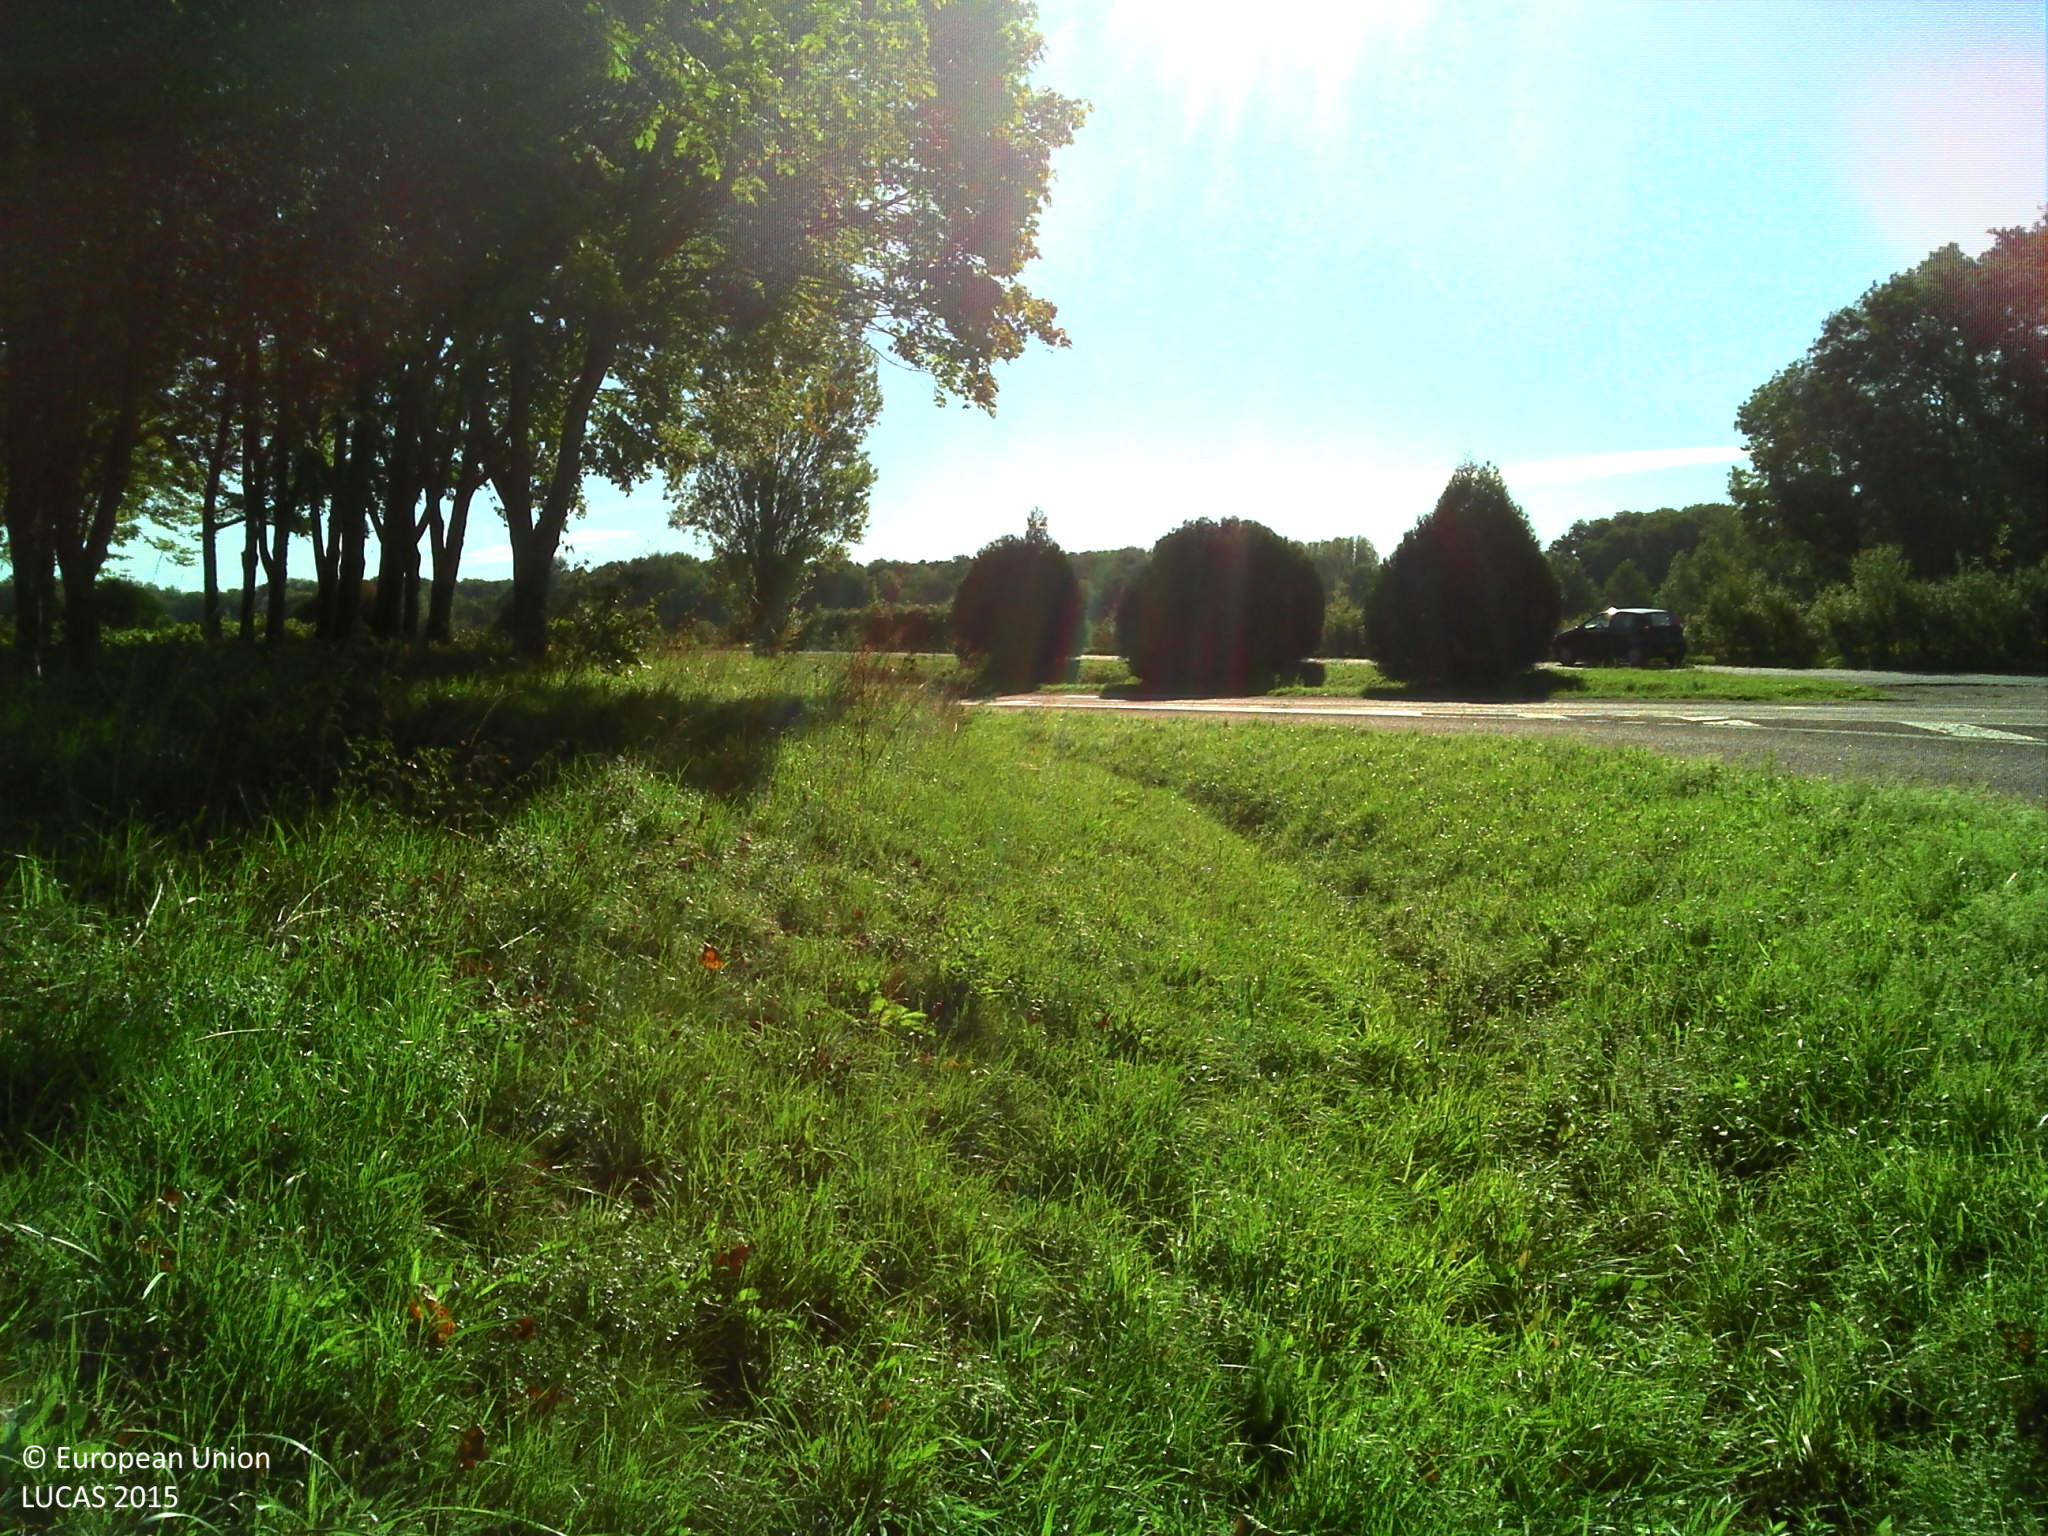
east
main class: Woodland
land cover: Broadleaved woodland
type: mesophytic deciduous forest
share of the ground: > 75 %
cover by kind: broadleaved forest trees 70 %, herbaceous plants 30 %
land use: Semi-natural and natural areas not in use
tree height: > 5 m
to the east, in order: Broadleaved woodland; Ditches and canals; Grass margins; Paved roads, cycling and walking lanes; Grass margins; Ditches and canals; Lines of trees; Grassland without tree/shrub cover; Paved roads, cycling and walking lanes; Grass margins; Managed hedges; Fences; Grassland without tree/shrub cover
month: September
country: FR
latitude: 48.2399
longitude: 4.3284
